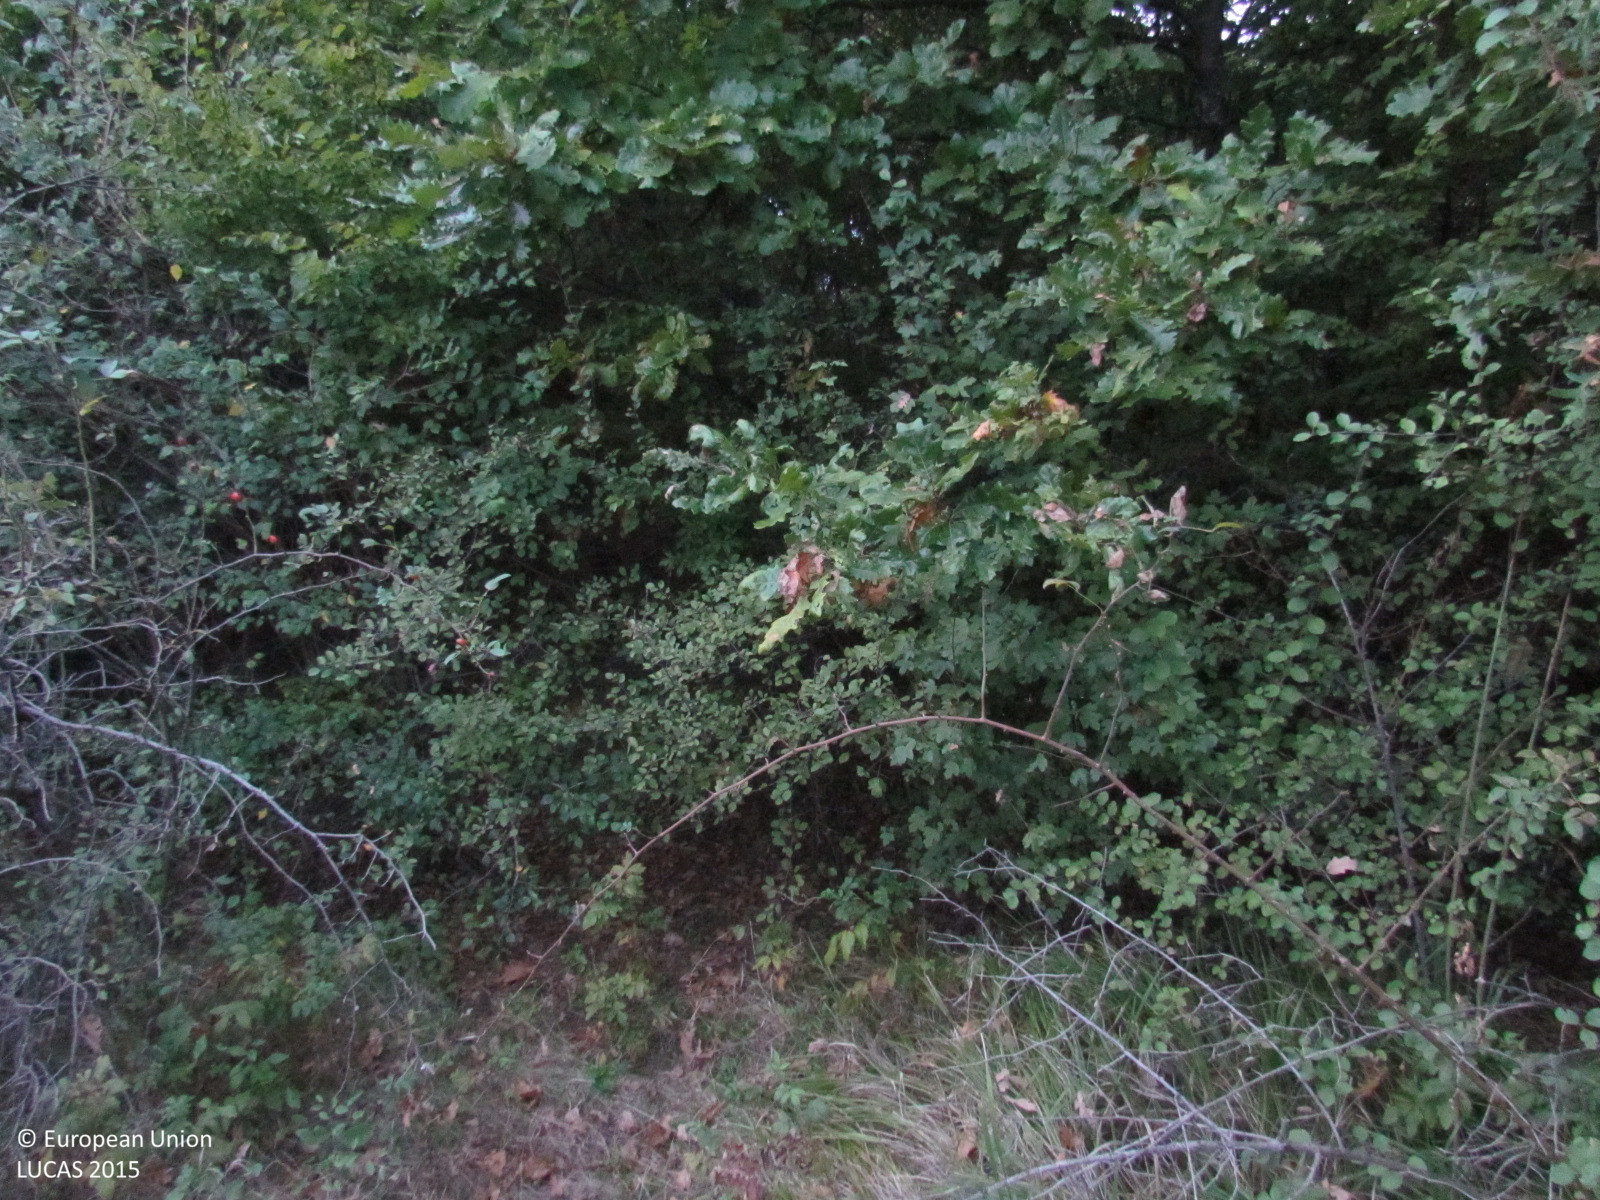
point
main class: Woodland
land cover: Broadleaved woodland
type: acidophilous oak and oak-birch forest
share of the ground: > 75 %
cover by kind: broadleaved forest trees 80 %, shrubs 10 %, herbaceous plants 10 %
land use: Forestry
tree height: > 5 m
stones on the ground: < 10 %
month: October
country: BG
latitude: 42.6989
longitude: 26.7643
